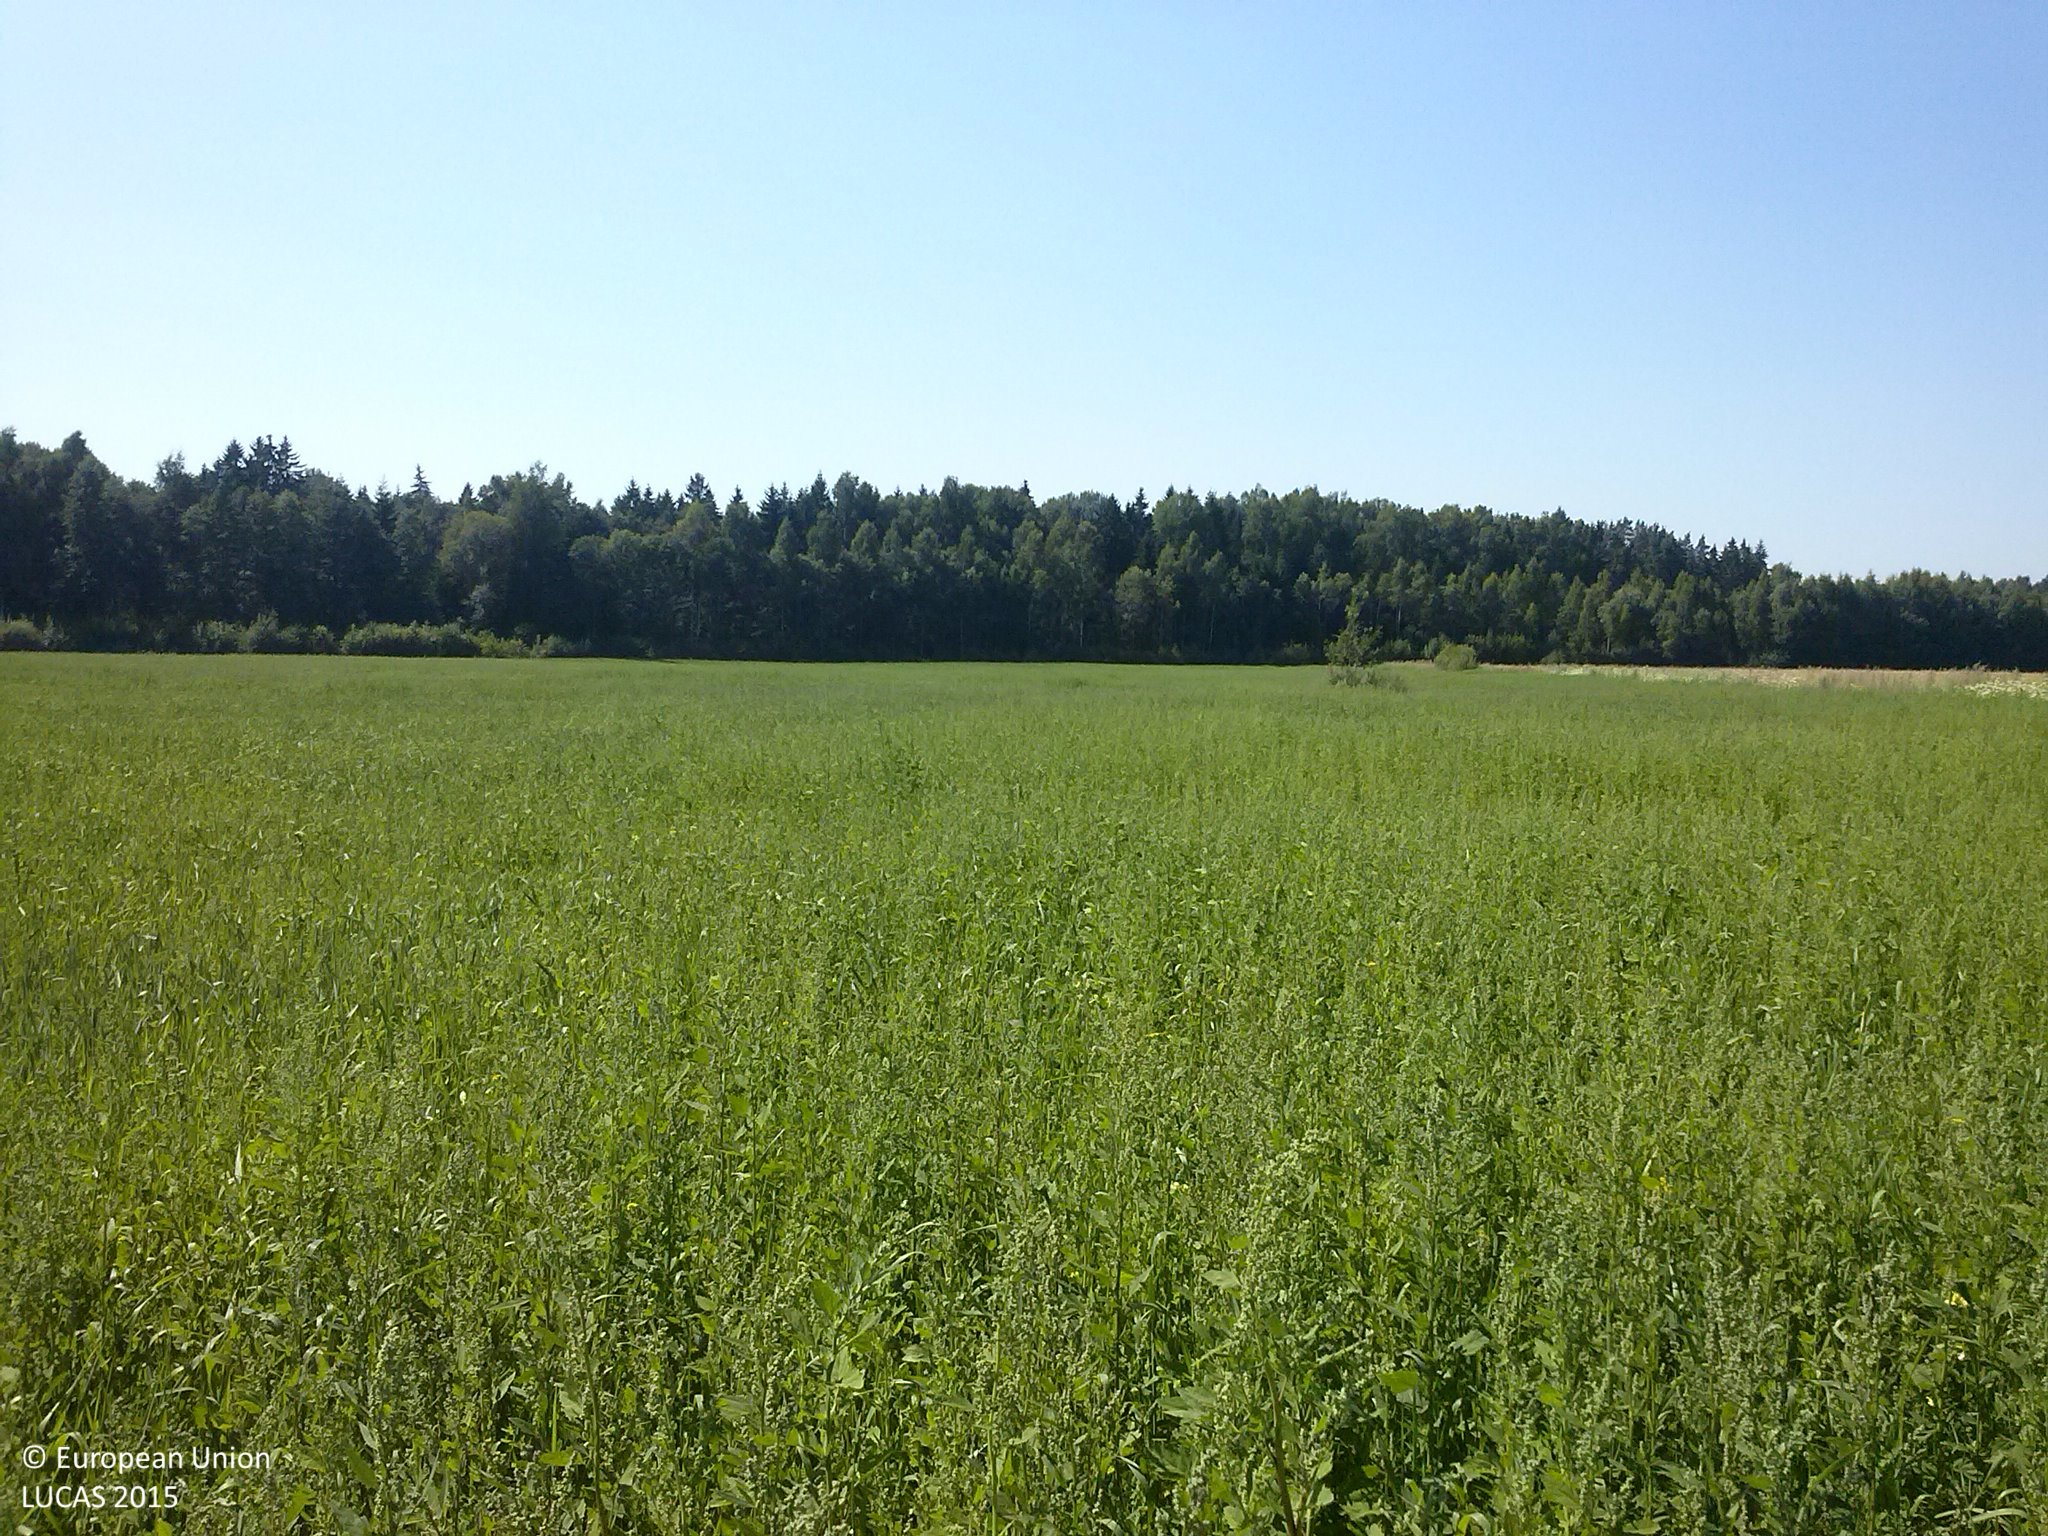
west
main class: Grassland
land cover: Grassland without tree/shrub cover
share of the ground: > 75 %
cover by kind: herbaceous plants 100 %
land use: Agriculture (excluding fallow land and kitchen gardens)
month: August
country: LV
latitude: 56.7344
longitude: 27.8270
